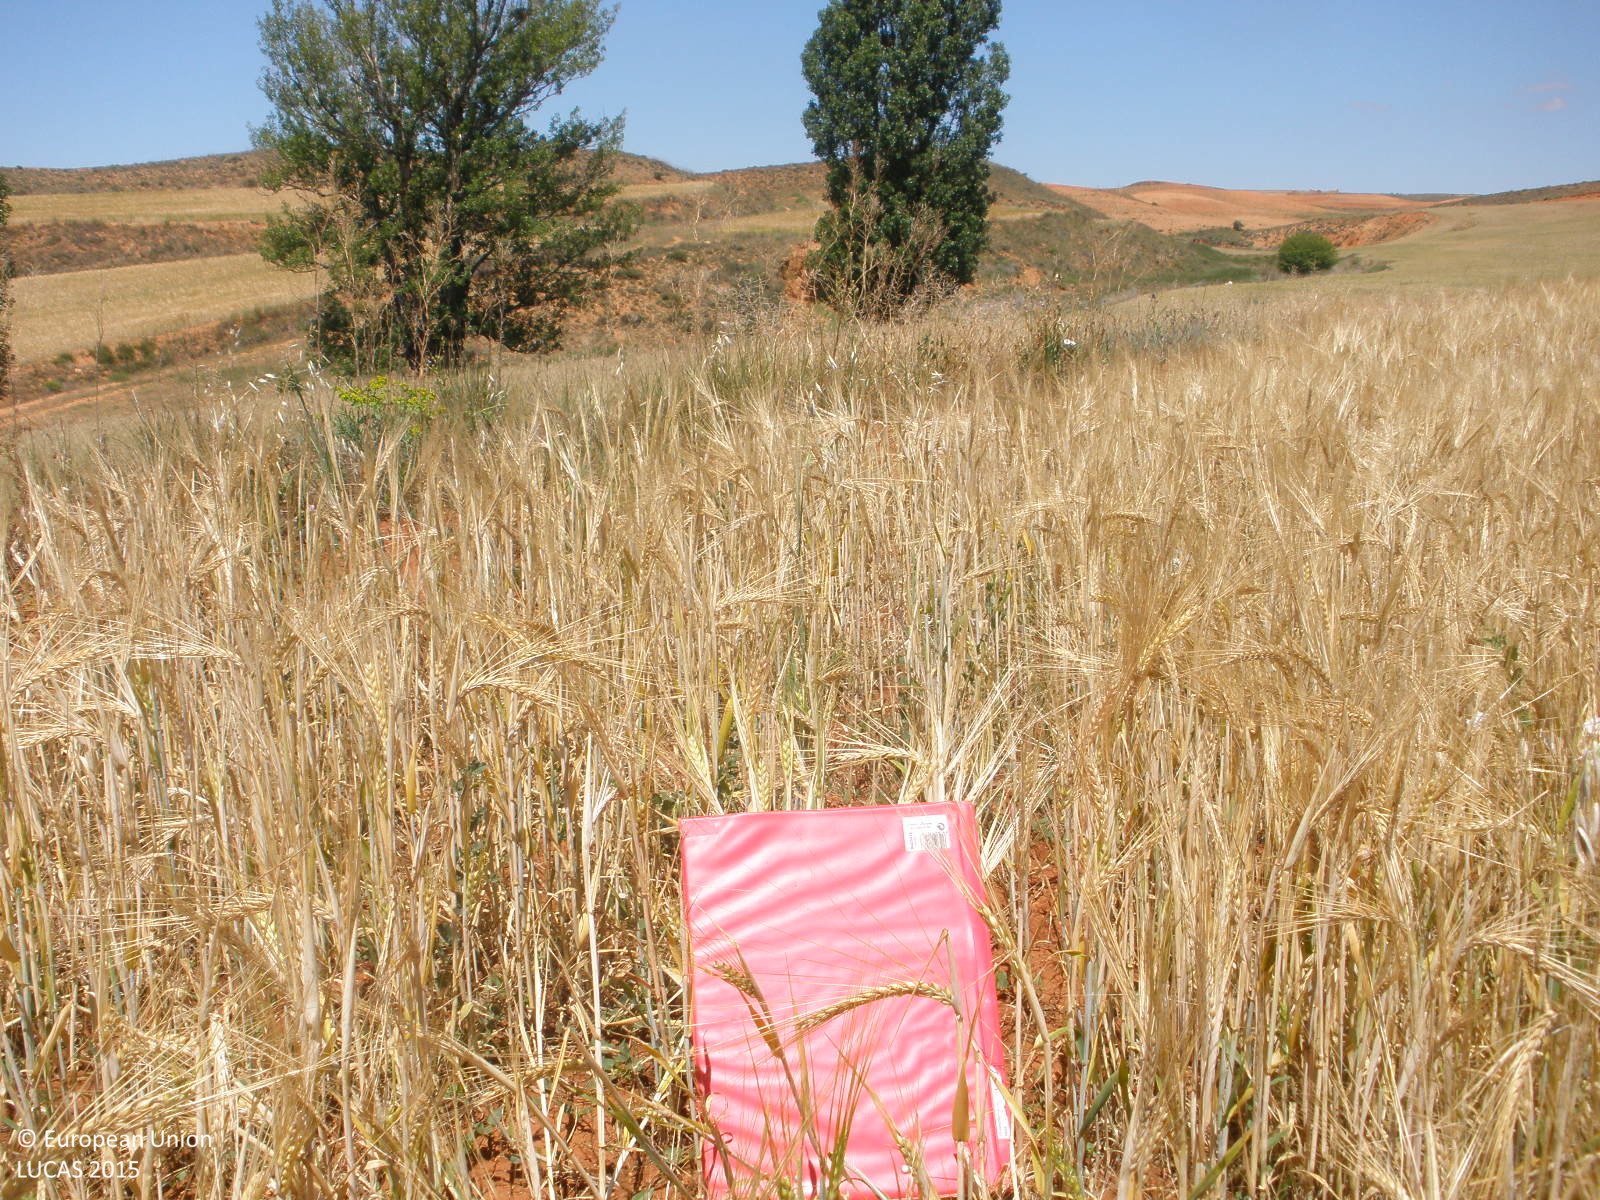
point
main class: Cropland
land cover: Barley
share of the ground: > 75 %
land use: Agriculture (excluding fallow land and kitchen gardens)
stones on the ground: < 10 %
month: June
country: ES
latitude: 40.5528
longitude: -1.0539
